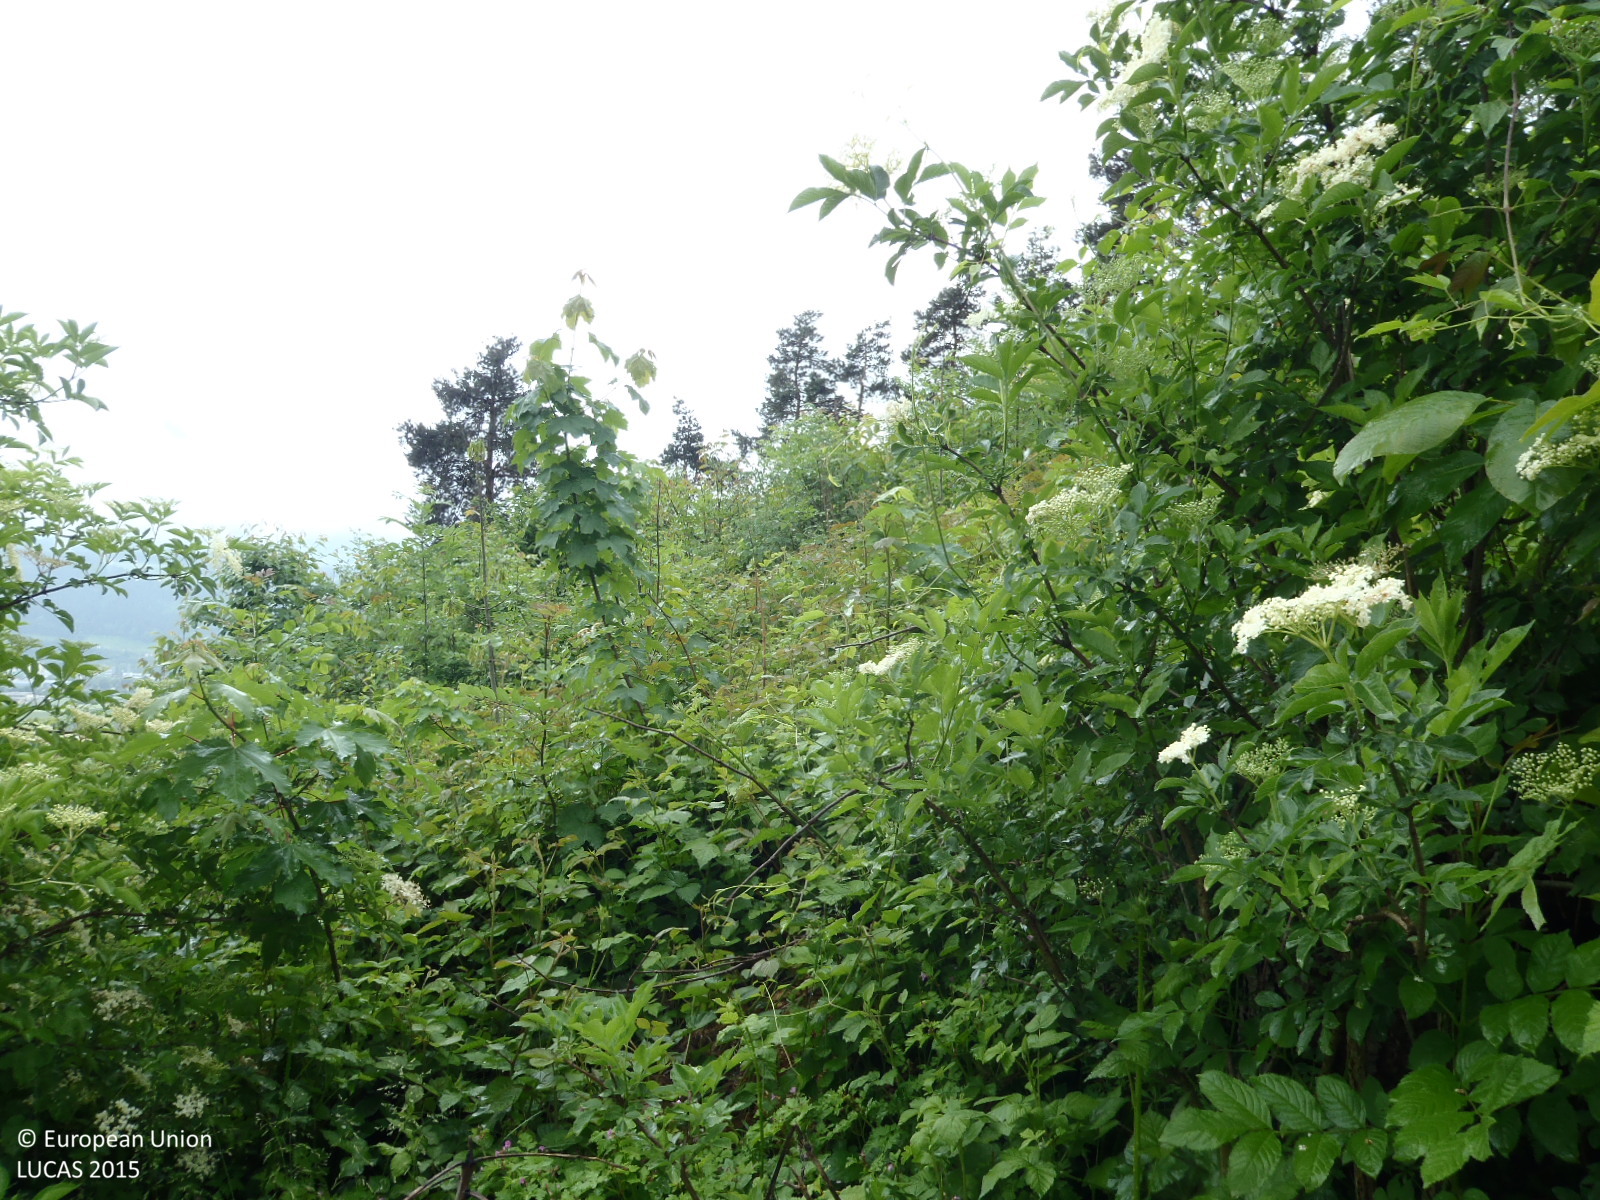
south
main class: Shrubland
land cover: Shrubland with sparse tree cover
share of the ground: > 75 %
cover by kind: shrubs 85 %, herbaceous plants 10 %, broadleaved forest trees 5 %
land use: Forestry
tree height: < 5 m
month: May
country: AT
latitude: 47.2957
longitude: 11.4666
